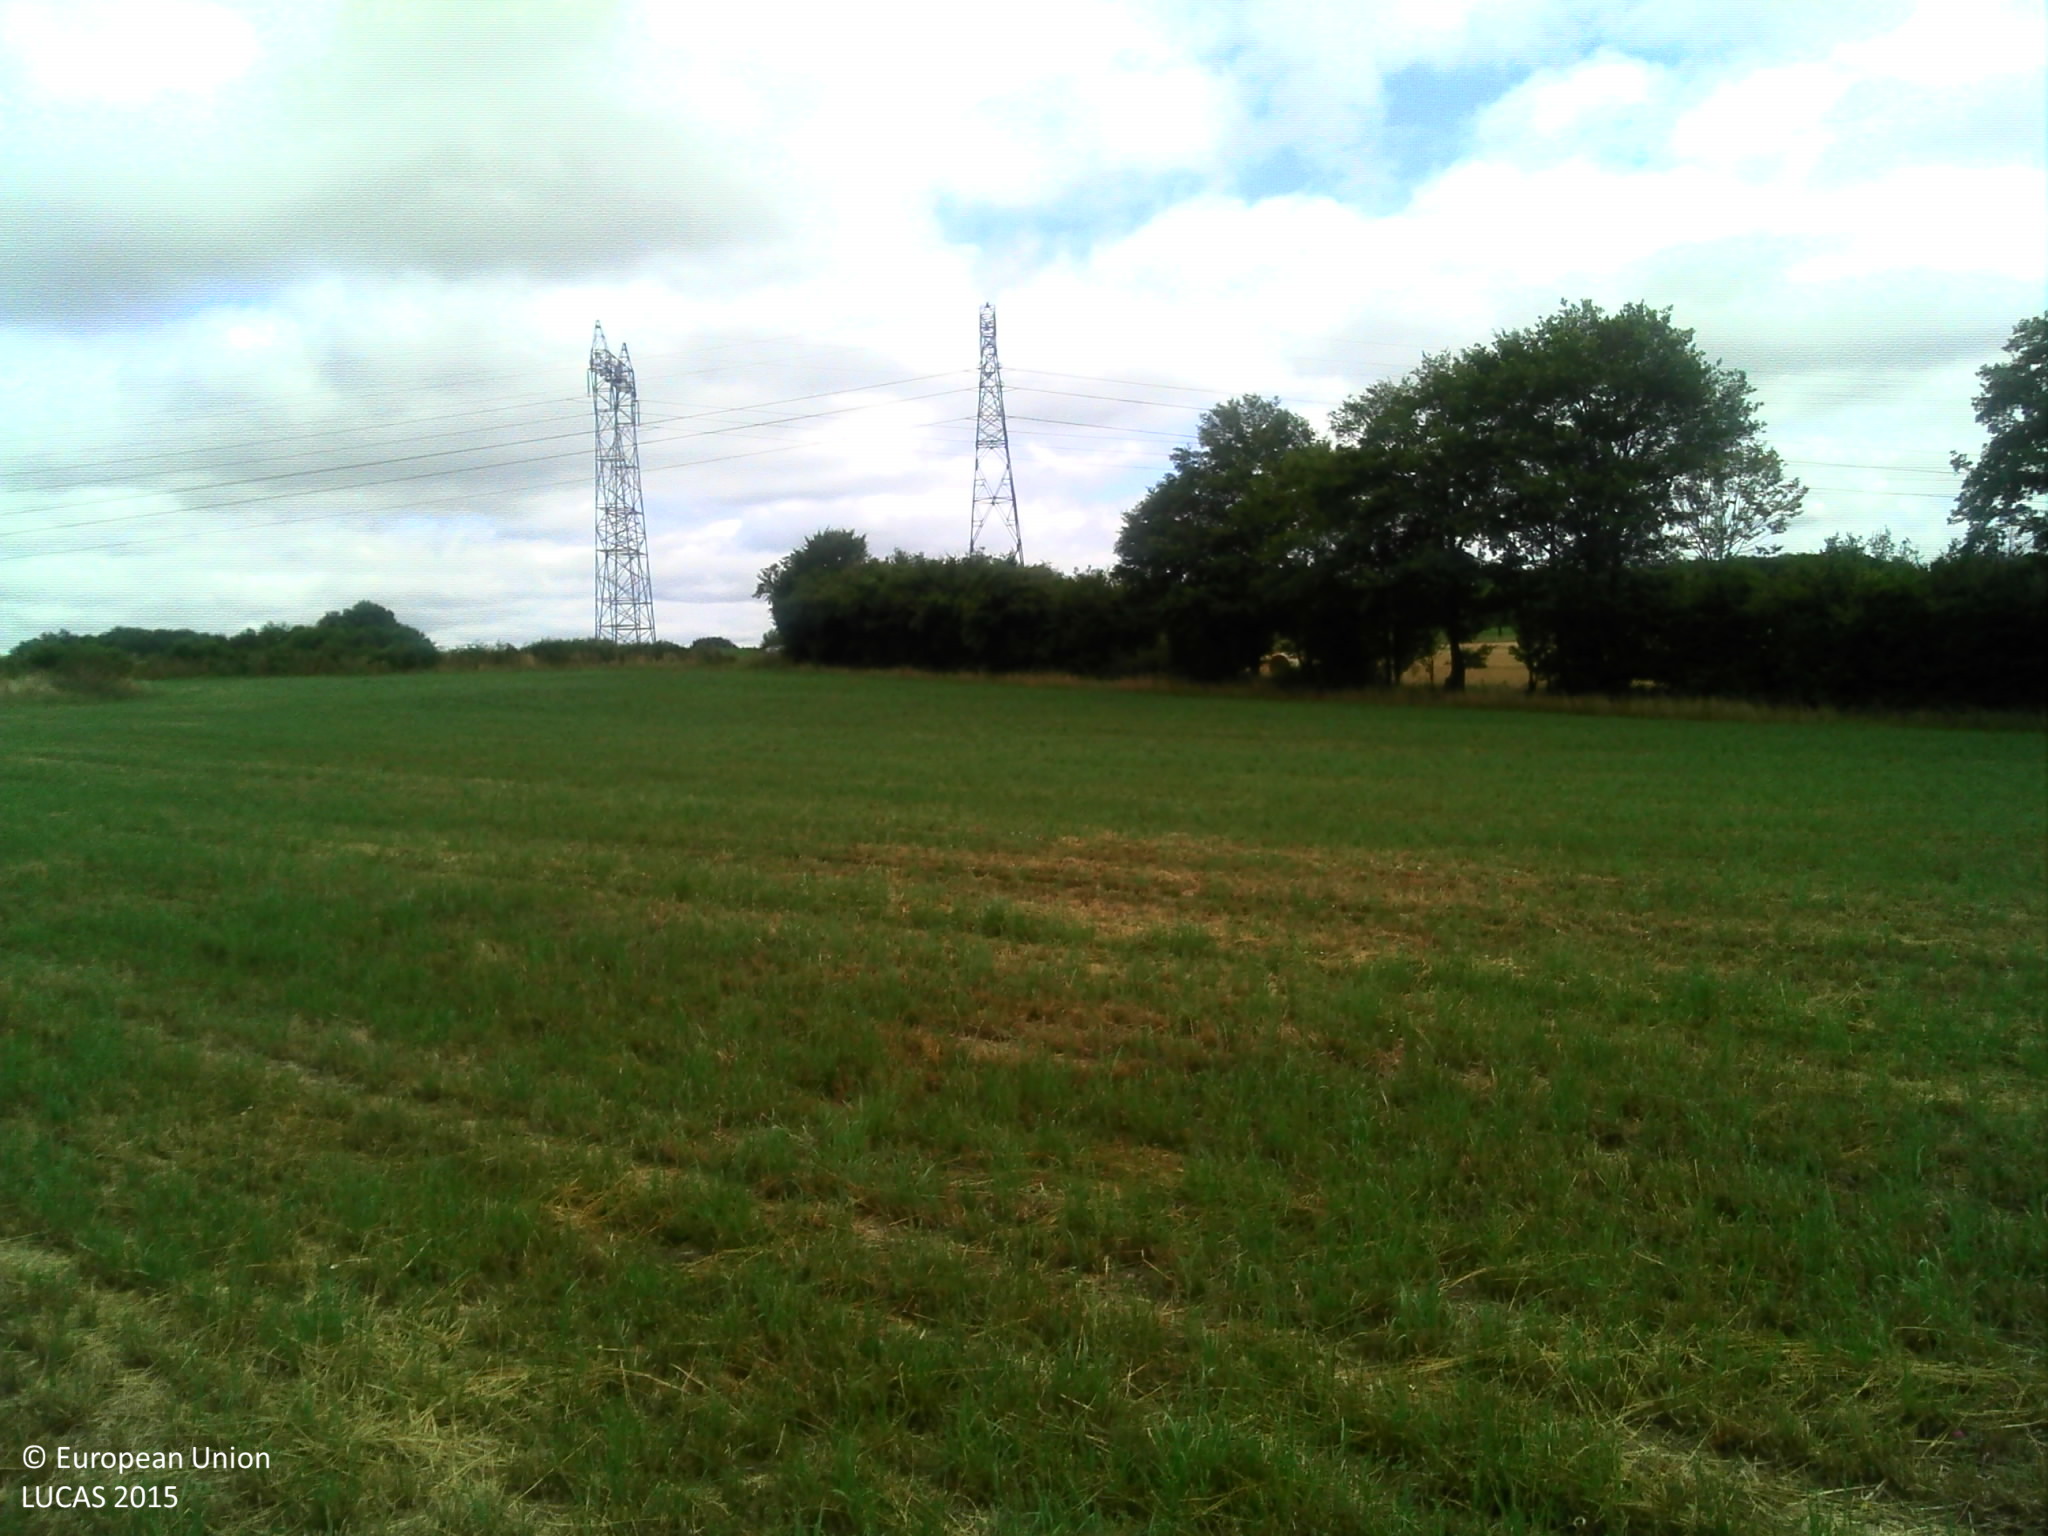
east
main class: Cropland
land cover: Temporary grasslands
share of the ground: > 75 %
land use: Agriculture (excluding fallow land and kitchen gardens)
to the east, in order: Temporary grasslands; Ditches and canals; Fences; Abandoned hedges; Durum wheat; Electric lines; Durum wheat; Managed hedges; Grass margins; Paved roads, cycling and walking lanes; Ditches and canals; Grassland without tree/shrub cover; Electric lines; Apple fruit; Electric lines; Apple fruit; Grassland without tree/shrub cover
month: July
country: FR
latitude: 46.3490
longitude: 1.6357
